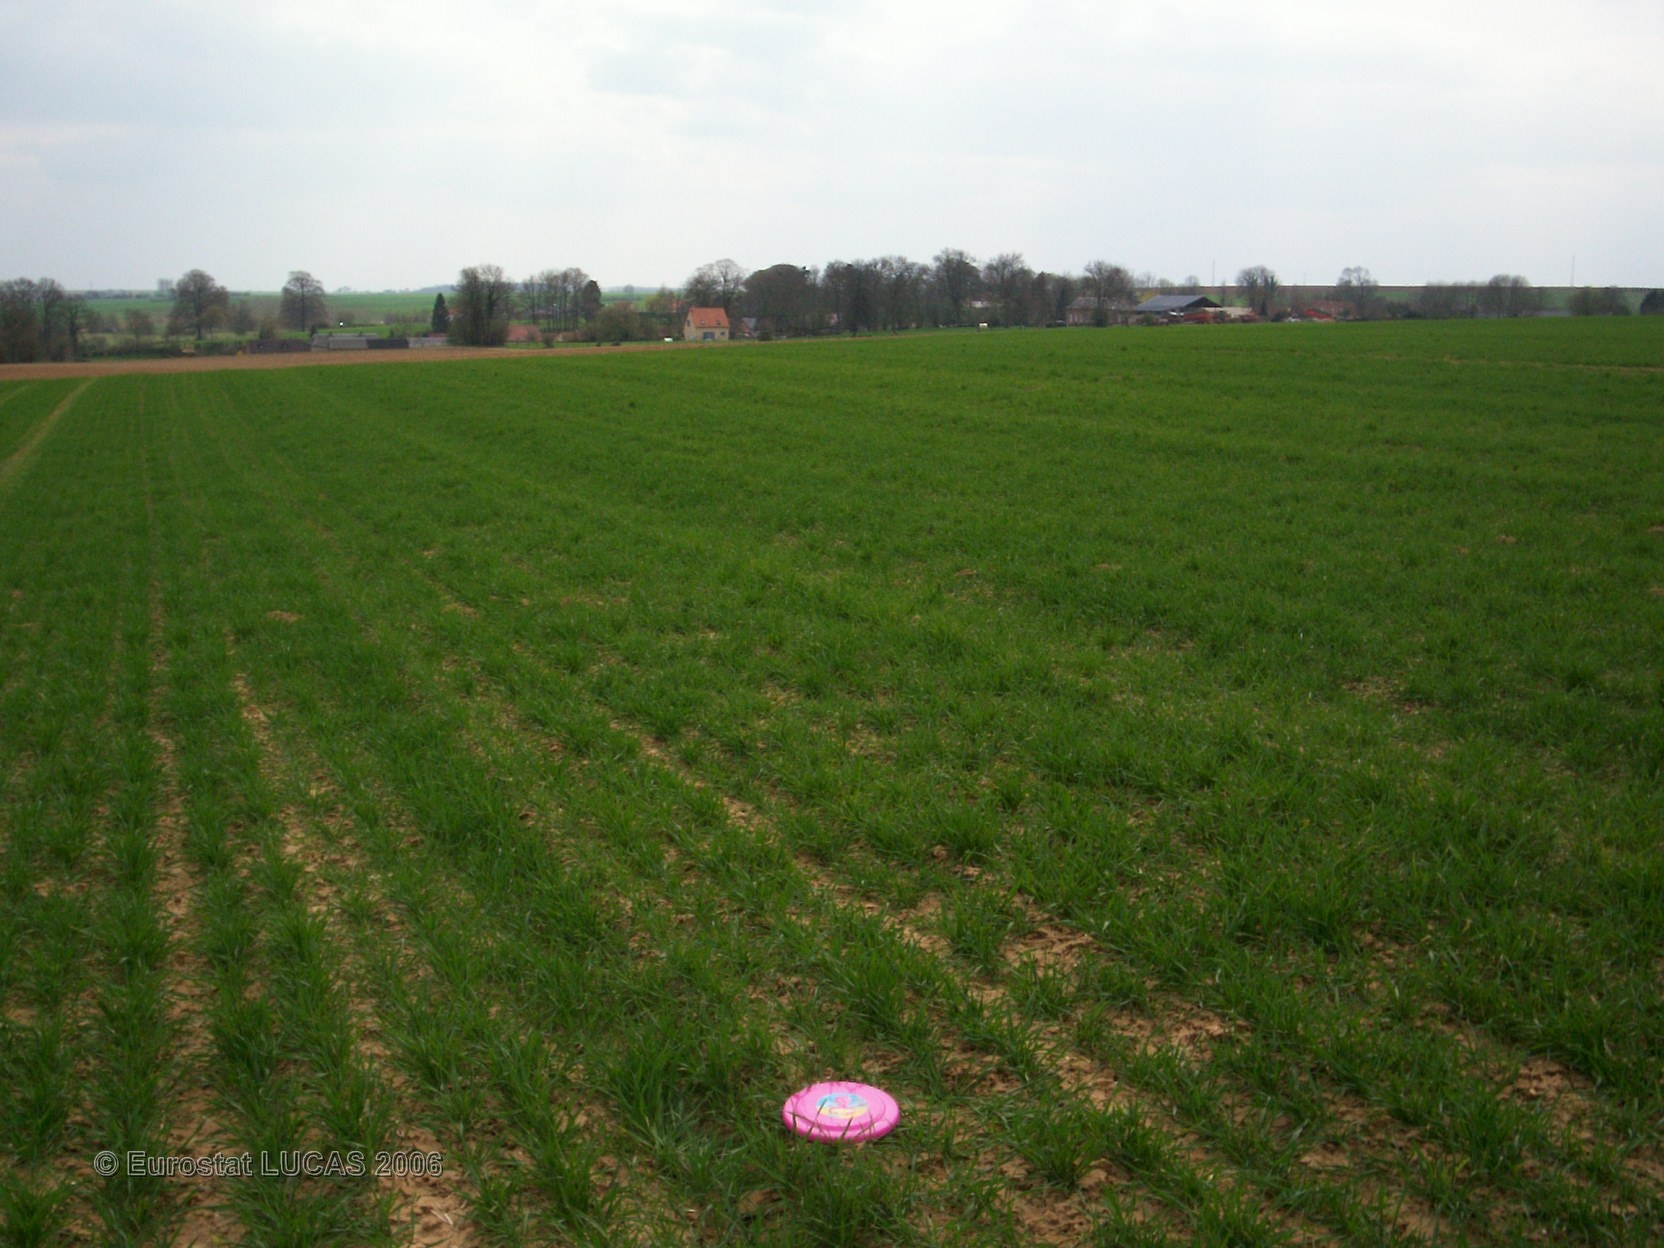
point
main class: Cropland
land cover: Common wheat
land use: Agriculture (excluding fallow land and kitchen gardens)
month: April
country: FR
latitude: 50.0502
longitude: 2.5722
